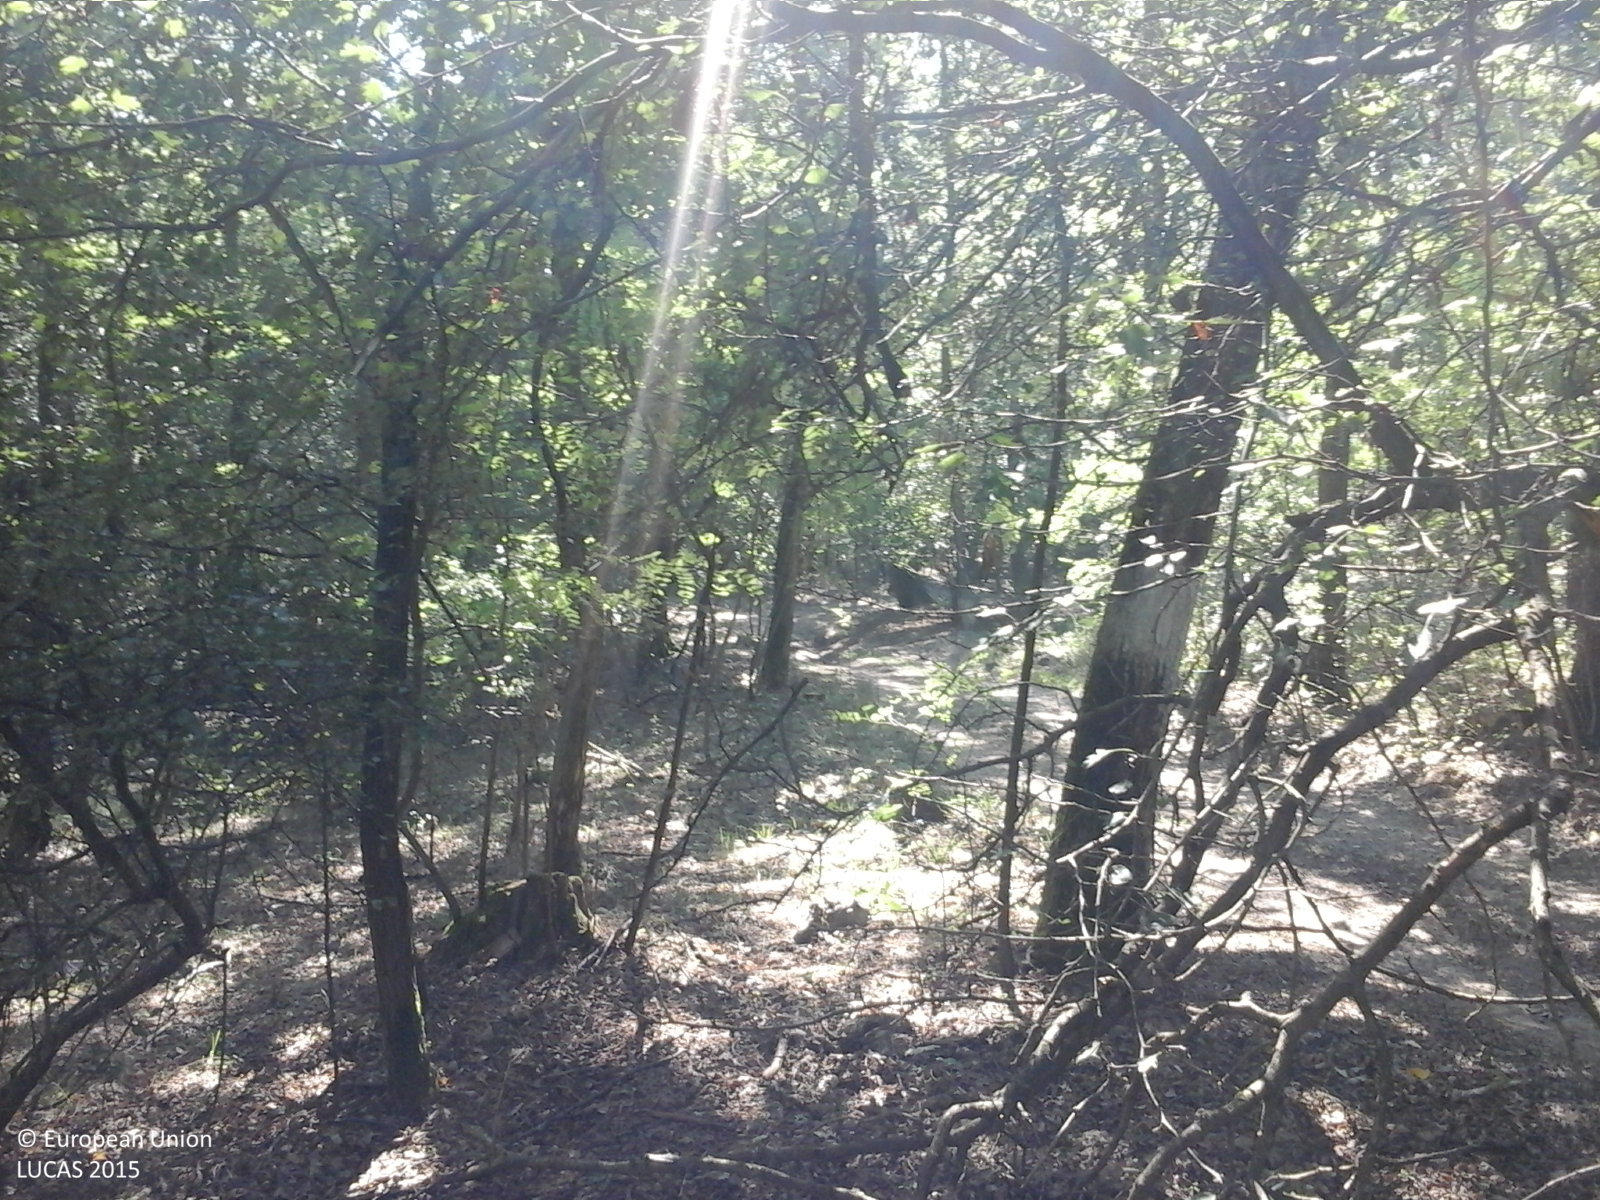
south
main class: Woodland
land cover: Broadleaved woodland
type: acidophilous oak and oak-birch forest
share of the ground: > 75 %
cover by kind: broadleaved forest trees 100 %
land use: Forestry
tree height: > 5 m
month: September
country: RO
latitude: 47.3545
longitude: 22.7293
